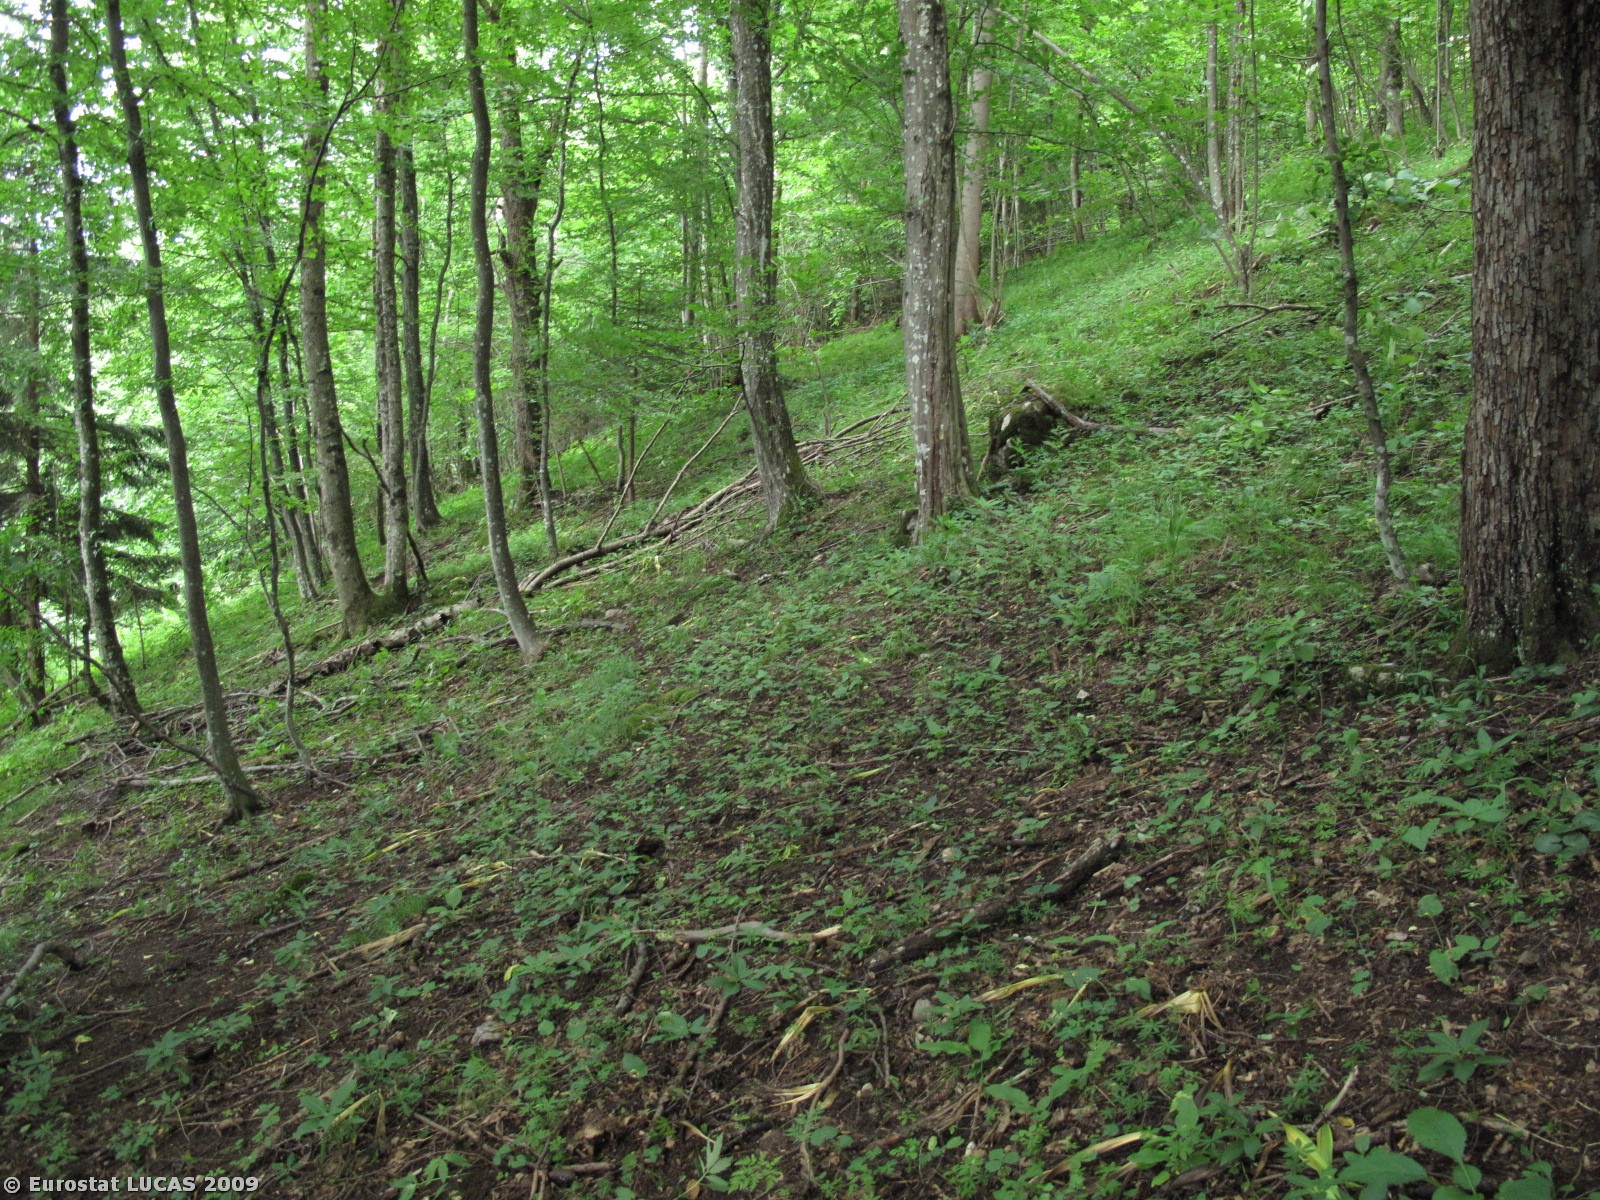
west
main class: Woodland
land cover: Mixed woodland
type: hemiboreal forest and nemoral coniferous forest and mixed broadleaved-coniferous forest
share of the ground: > 75 %
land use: Forestry
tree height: > 5 m
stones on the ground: < 10 %
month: July
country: AT
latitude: 47.9471
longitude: 15.3973
